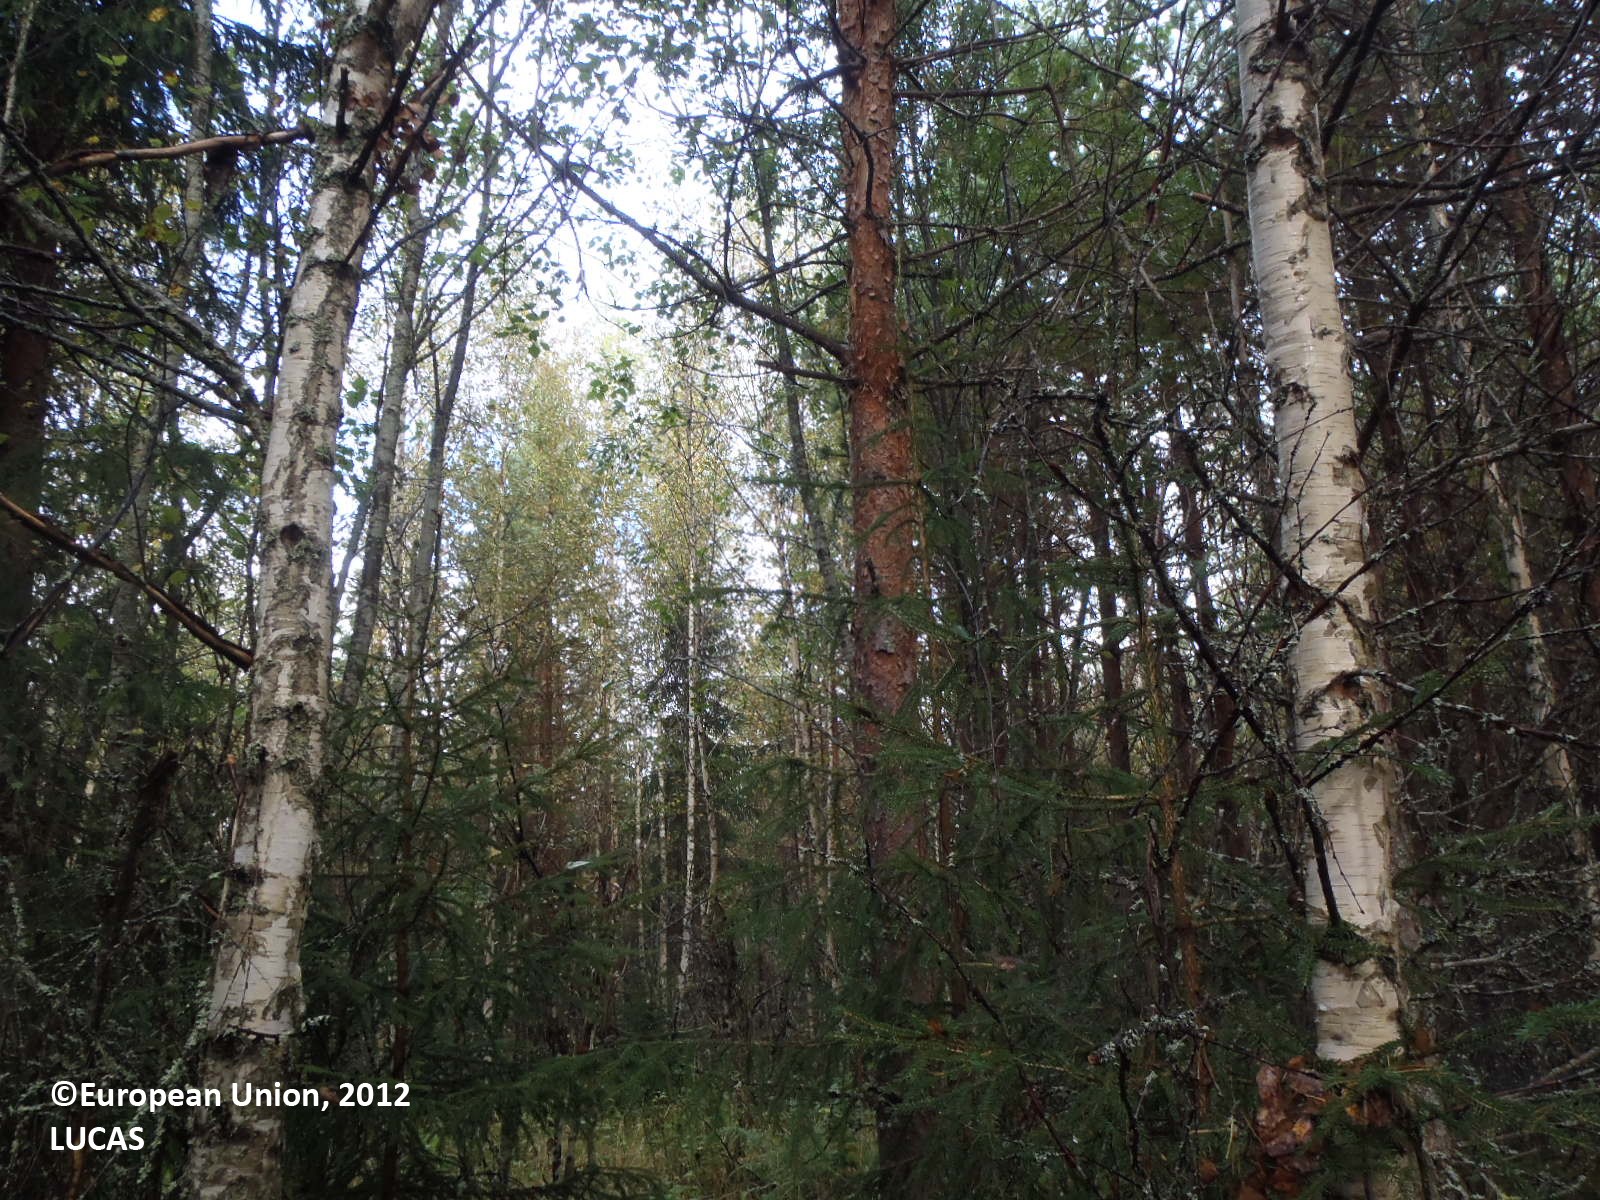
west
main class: Woodland
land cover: Pine dominated mixed woodland
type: boreal forest
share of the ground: > 75 %
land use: Forestry
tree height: > 5 m
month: September
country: FI
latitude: 61.6771
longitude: 22.8205
